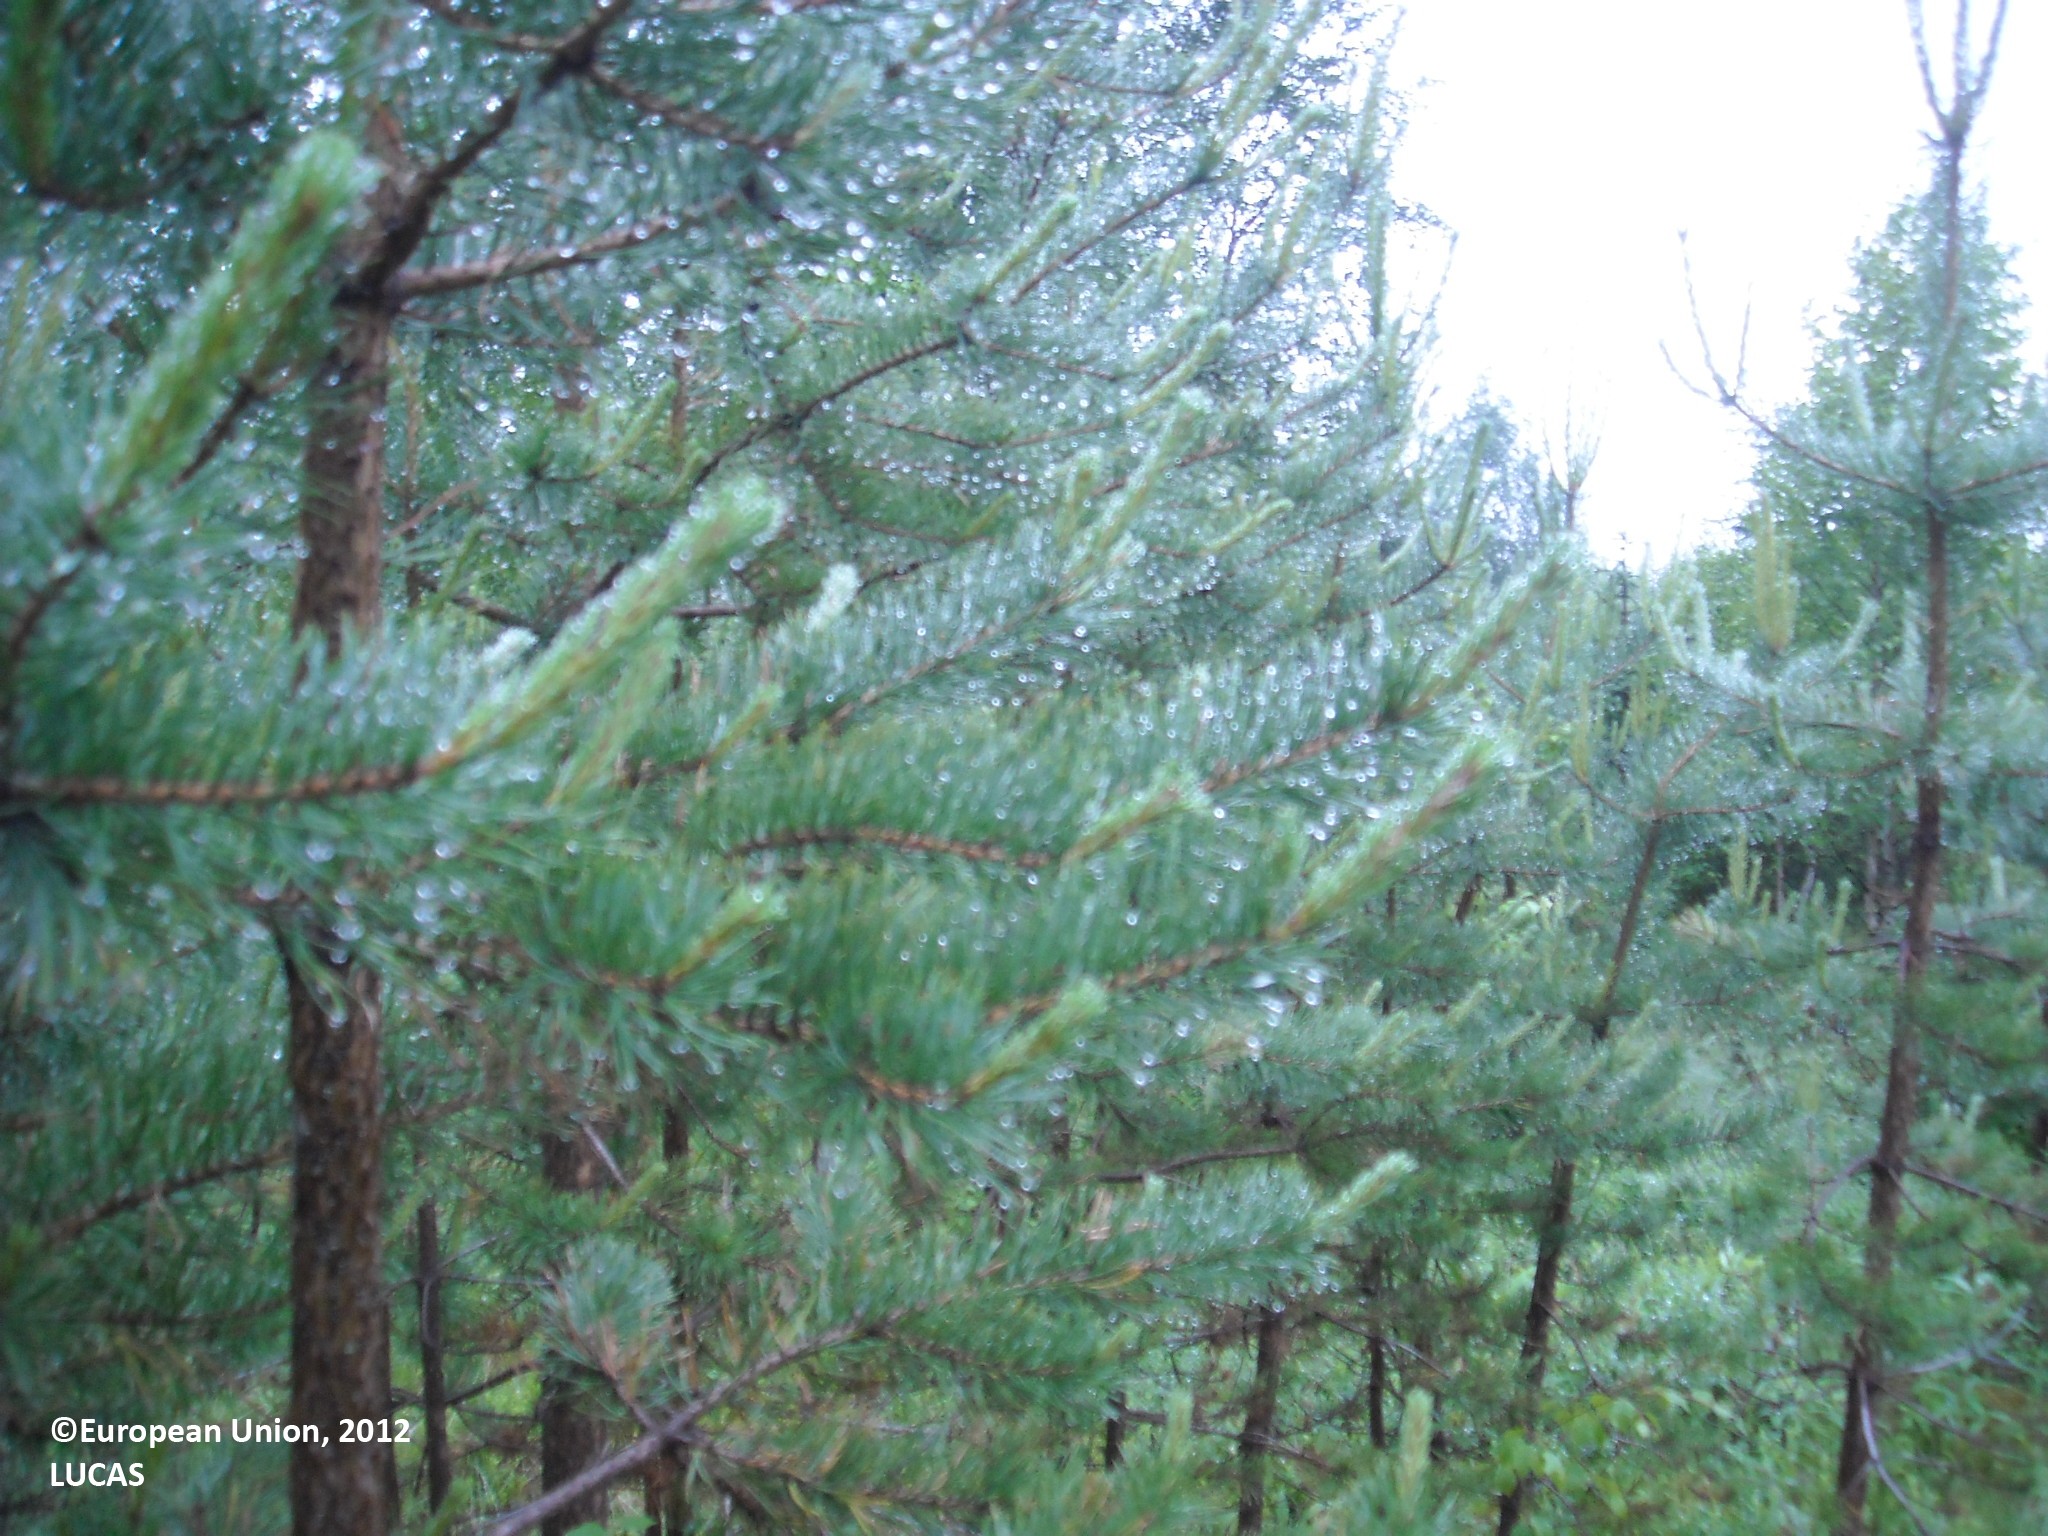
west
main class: Woodland
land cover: Pine dominated mixed woodland
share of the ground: > 75 %
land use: Forestry
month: July
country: FI
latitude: 64.5900
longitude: 27.6285
